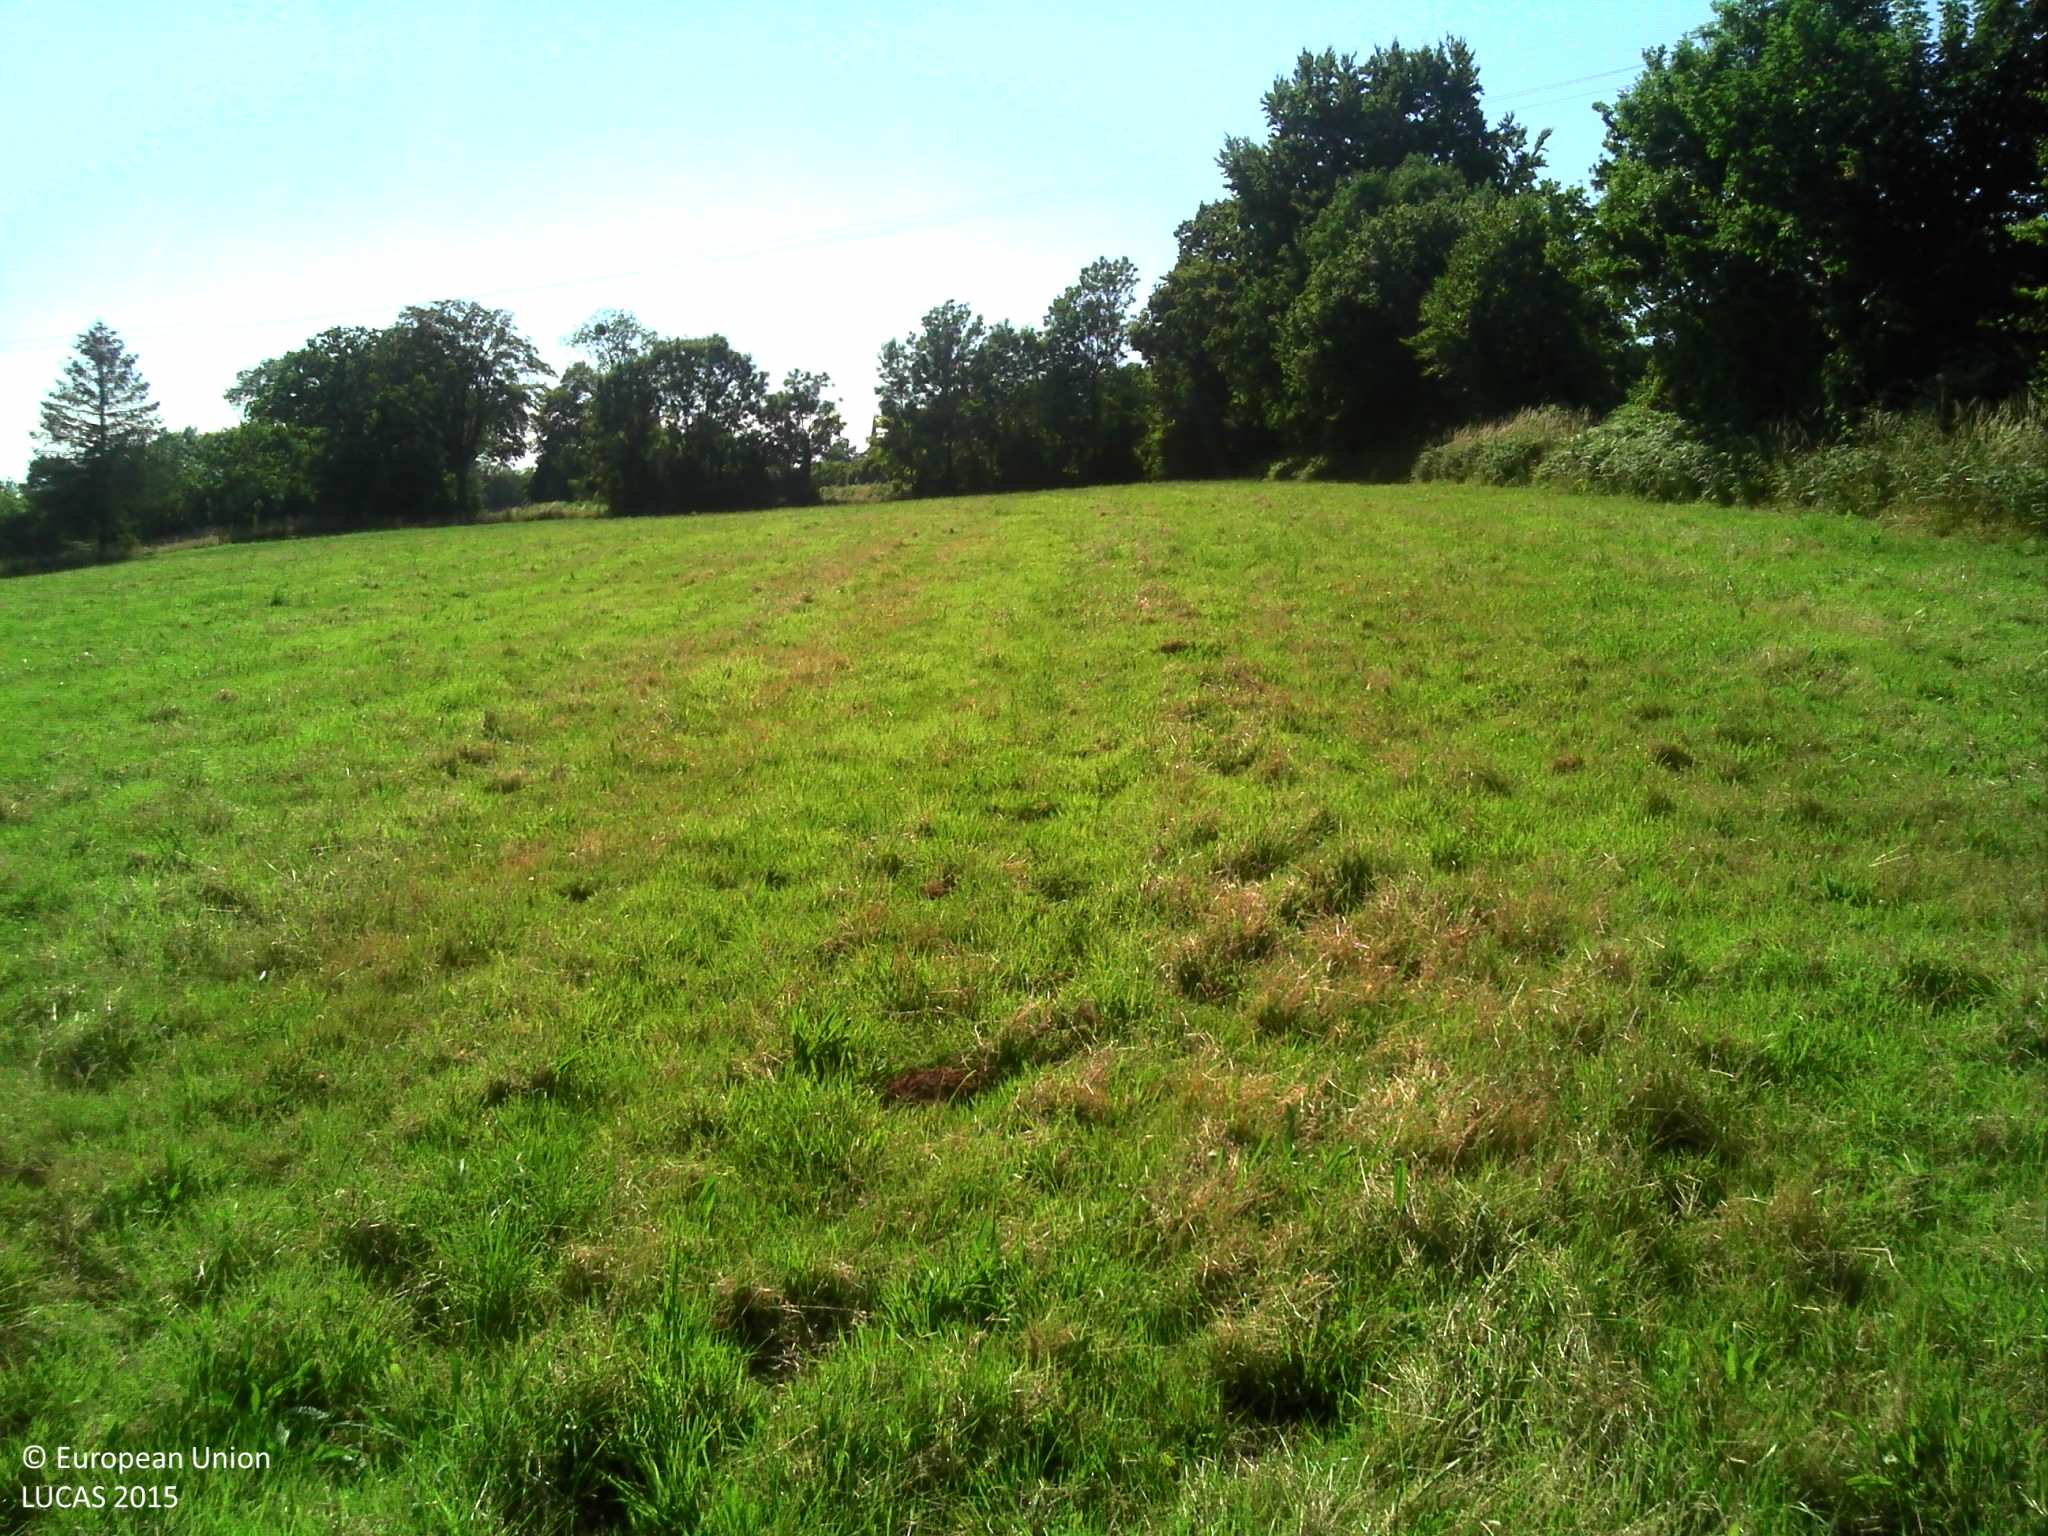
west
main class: Grassland
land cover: Grassland without tree/shrub cover
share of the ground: > 75 %
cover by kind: herbaceous plants 100 %
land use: Agriculture (excluding fallow land and kitchen gardens)
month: July
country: FR
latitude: 49.0211
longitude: -1.3000
